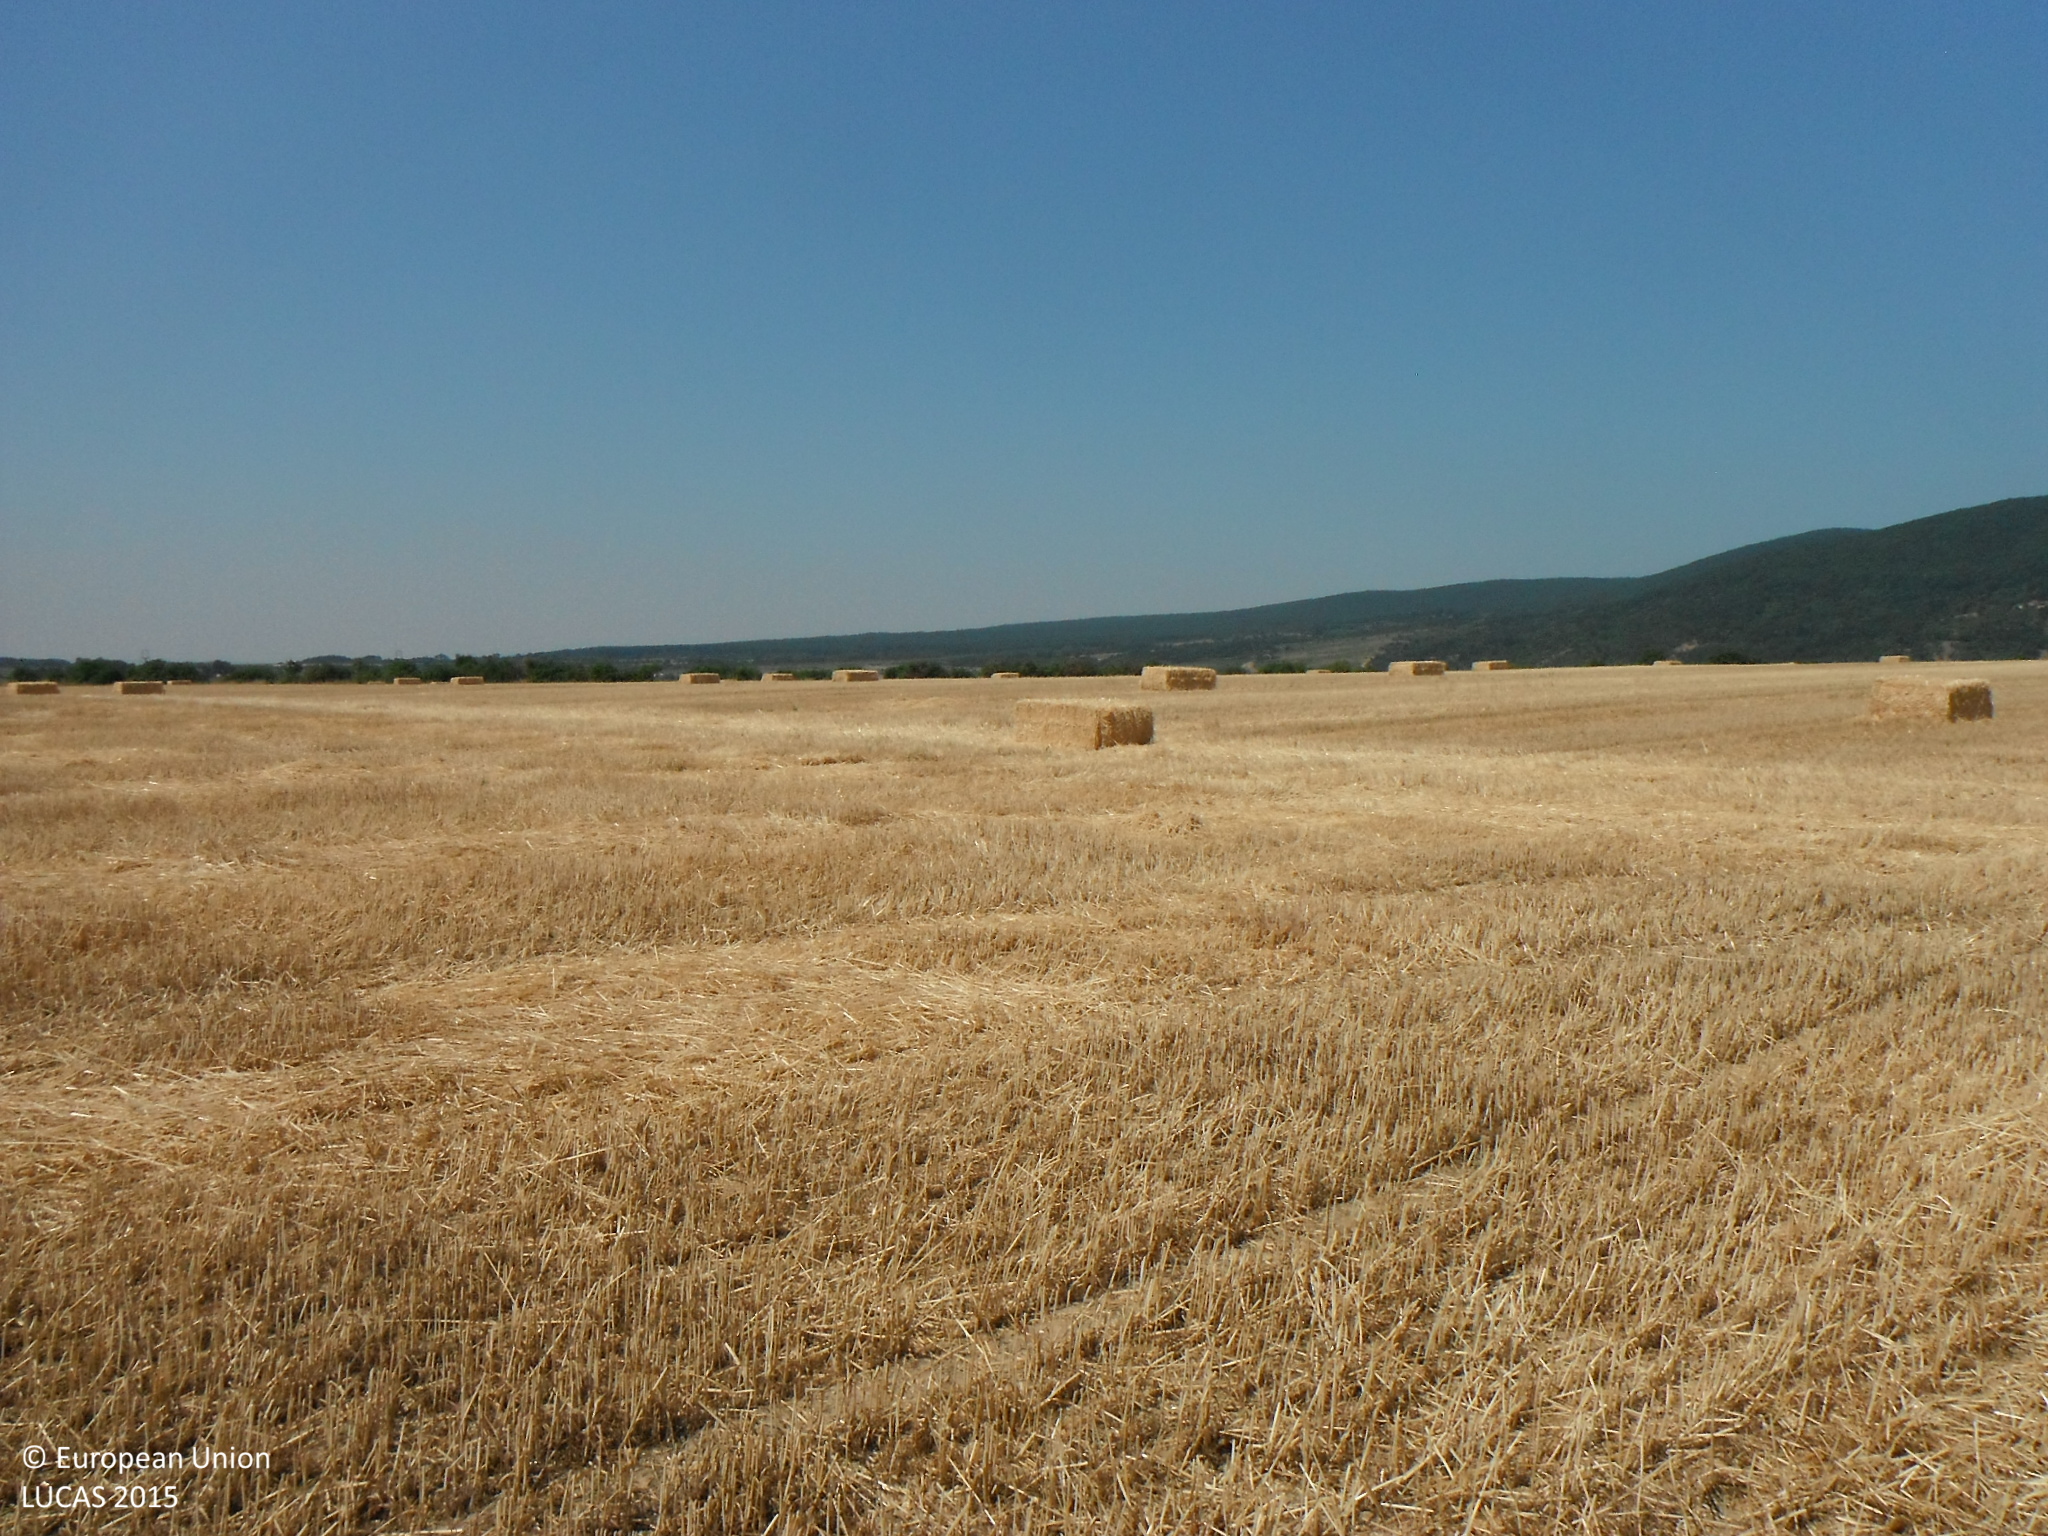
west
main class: Cropland
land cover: Common wheat
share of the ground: > 75 %
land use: Agriculture (excluding fallow land and kitchen gardens)
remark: Harvested field
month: July
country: SK
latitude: 48.3122
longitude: 18.7151
